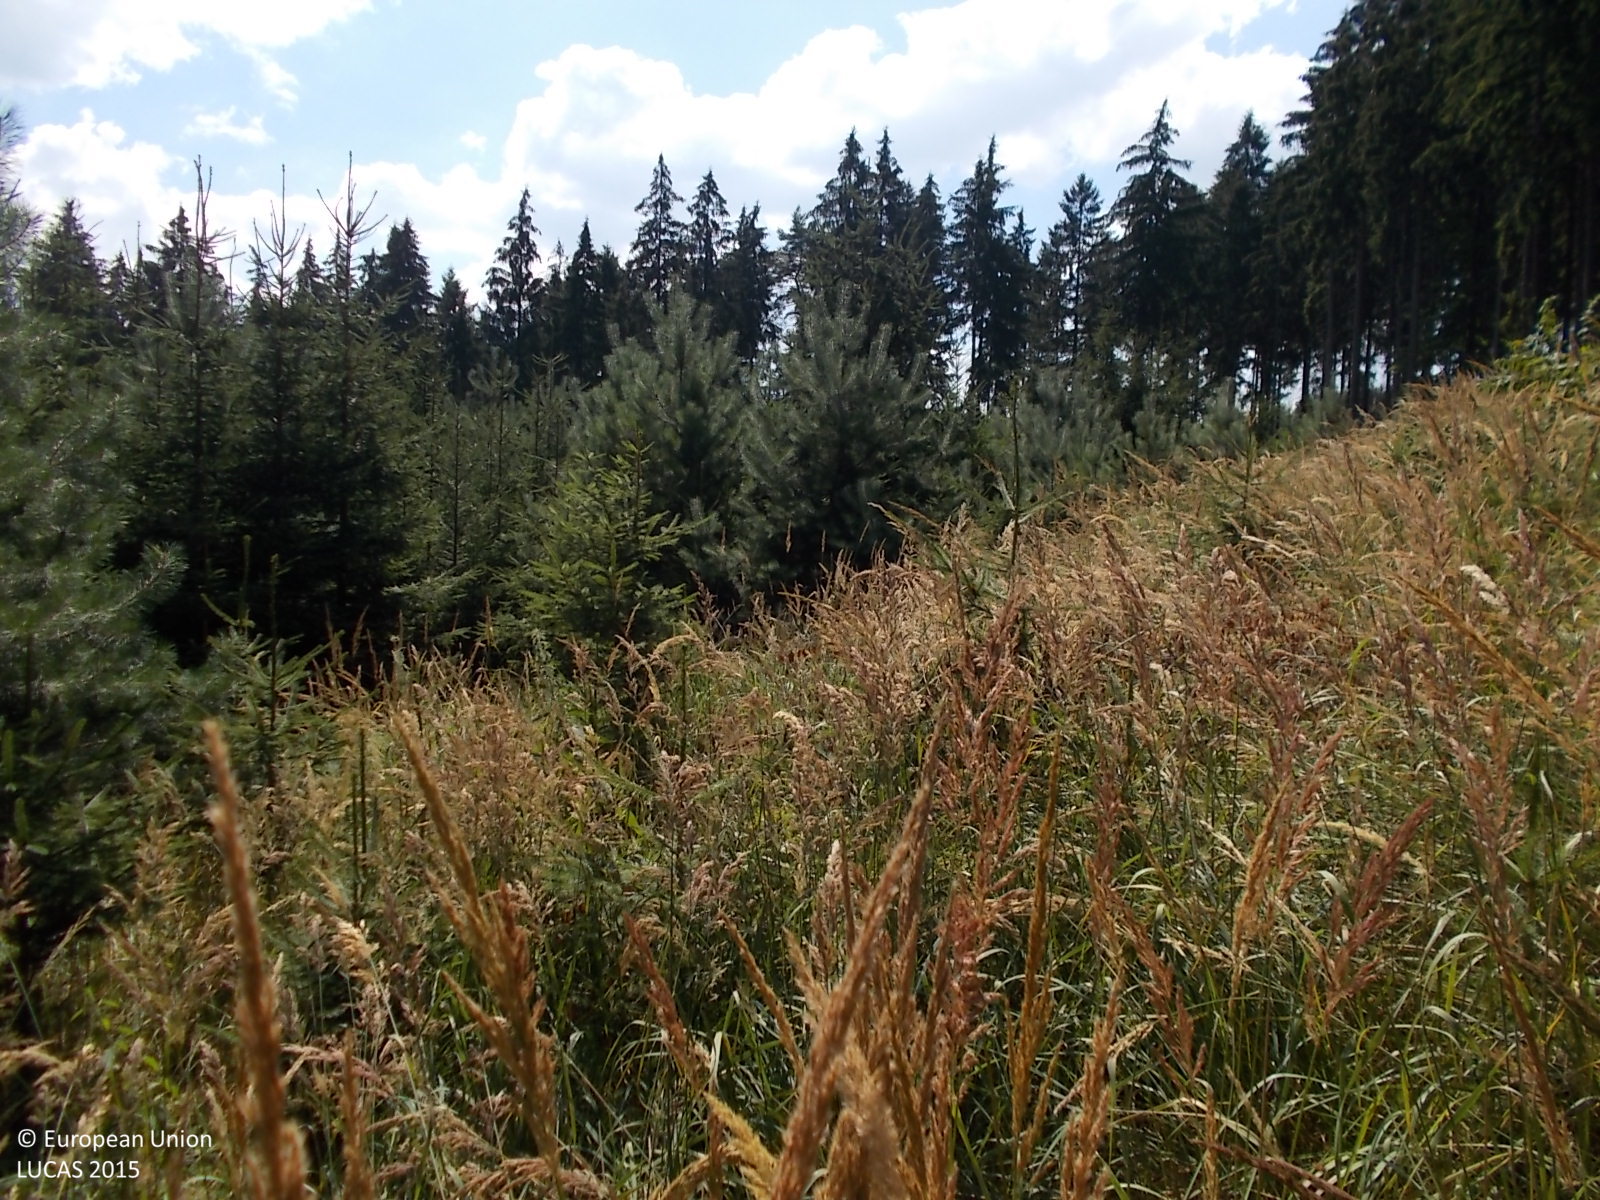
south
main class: Woodland
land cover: Other coniferous woodland
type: hemiboreal forest and nemoral coniferous forest and mixed broadleaved-coniferous forest
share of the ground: > 75 %
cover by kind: coniferous forest trees 75 %, herbaceous plants 15 %, broadleaved forest trees 5 %, shrubs 5 %
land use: Forestry
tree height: > 5 m
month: August
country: CZ
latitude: 50.3380
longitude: 17.1623
